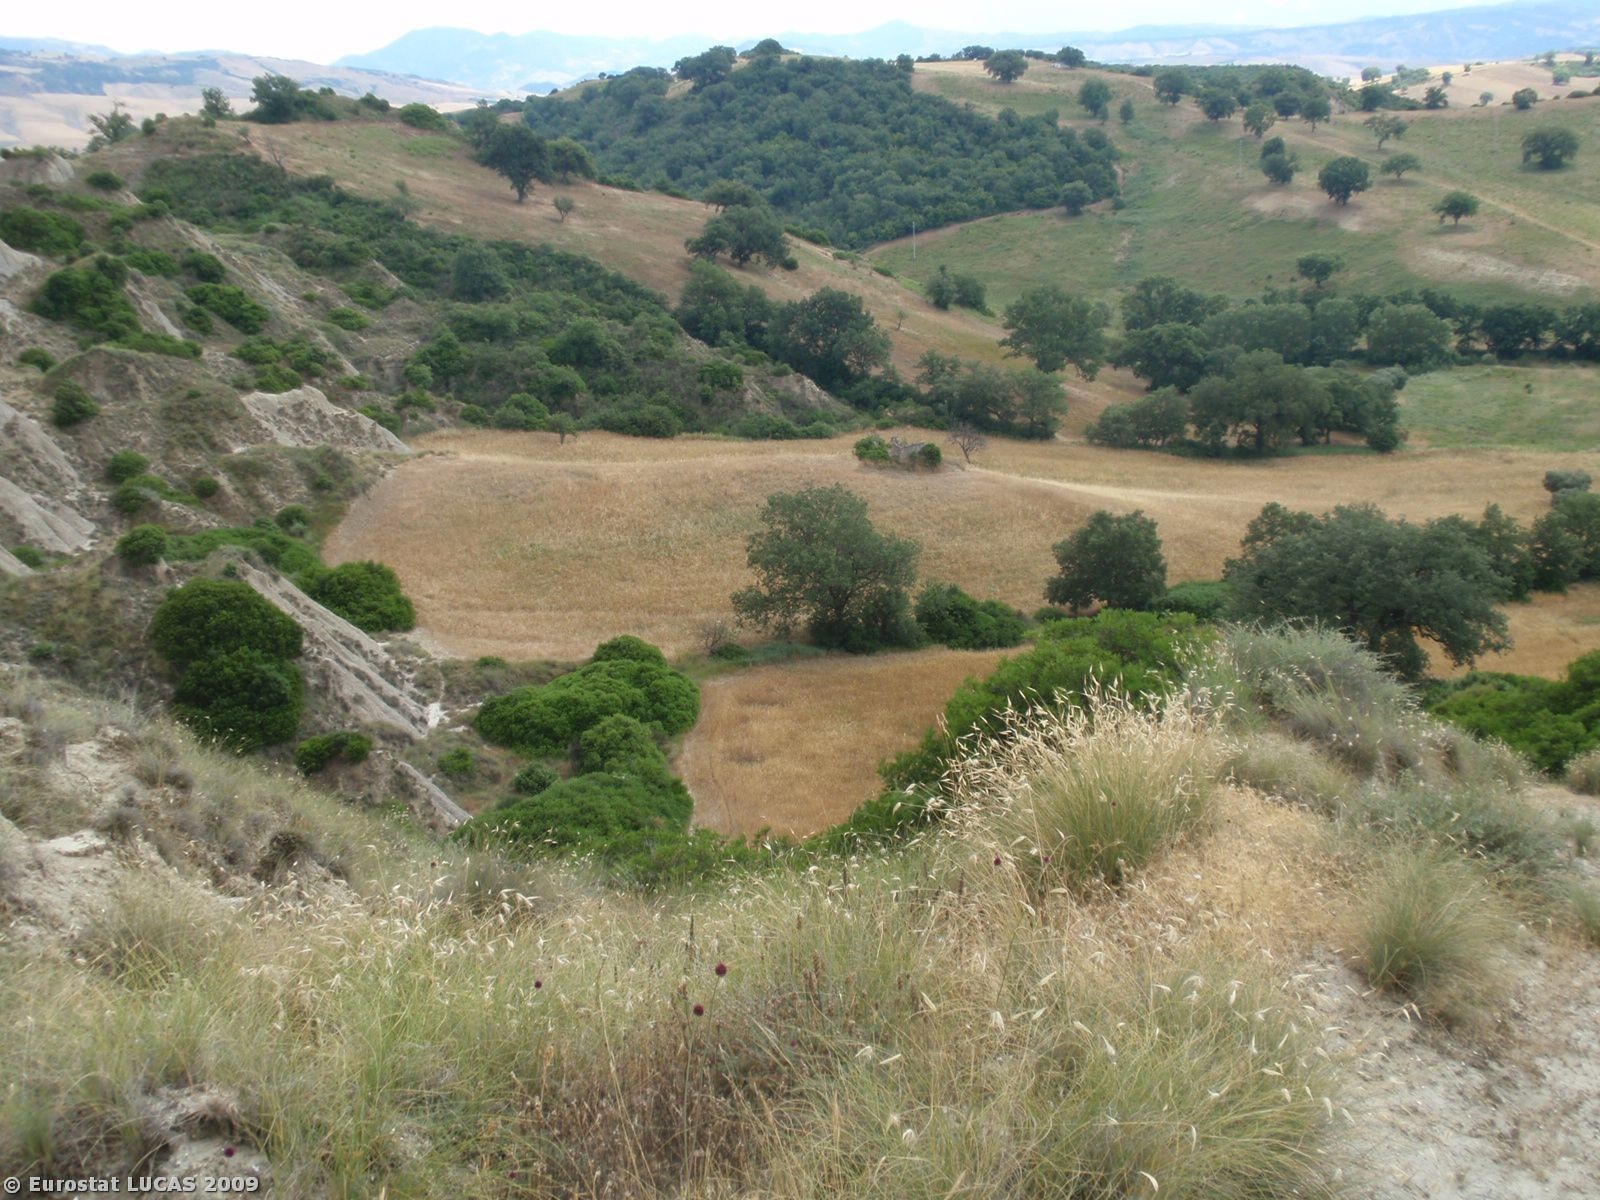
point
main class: Shrubland
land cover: Shrubland with sparse tree cover
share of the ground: > 75 %
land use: Agriculture (excluding fallow land and kitchen gardens)
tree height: < 5 m
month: June
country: IT
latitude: 40.2124
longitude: 16.2608
